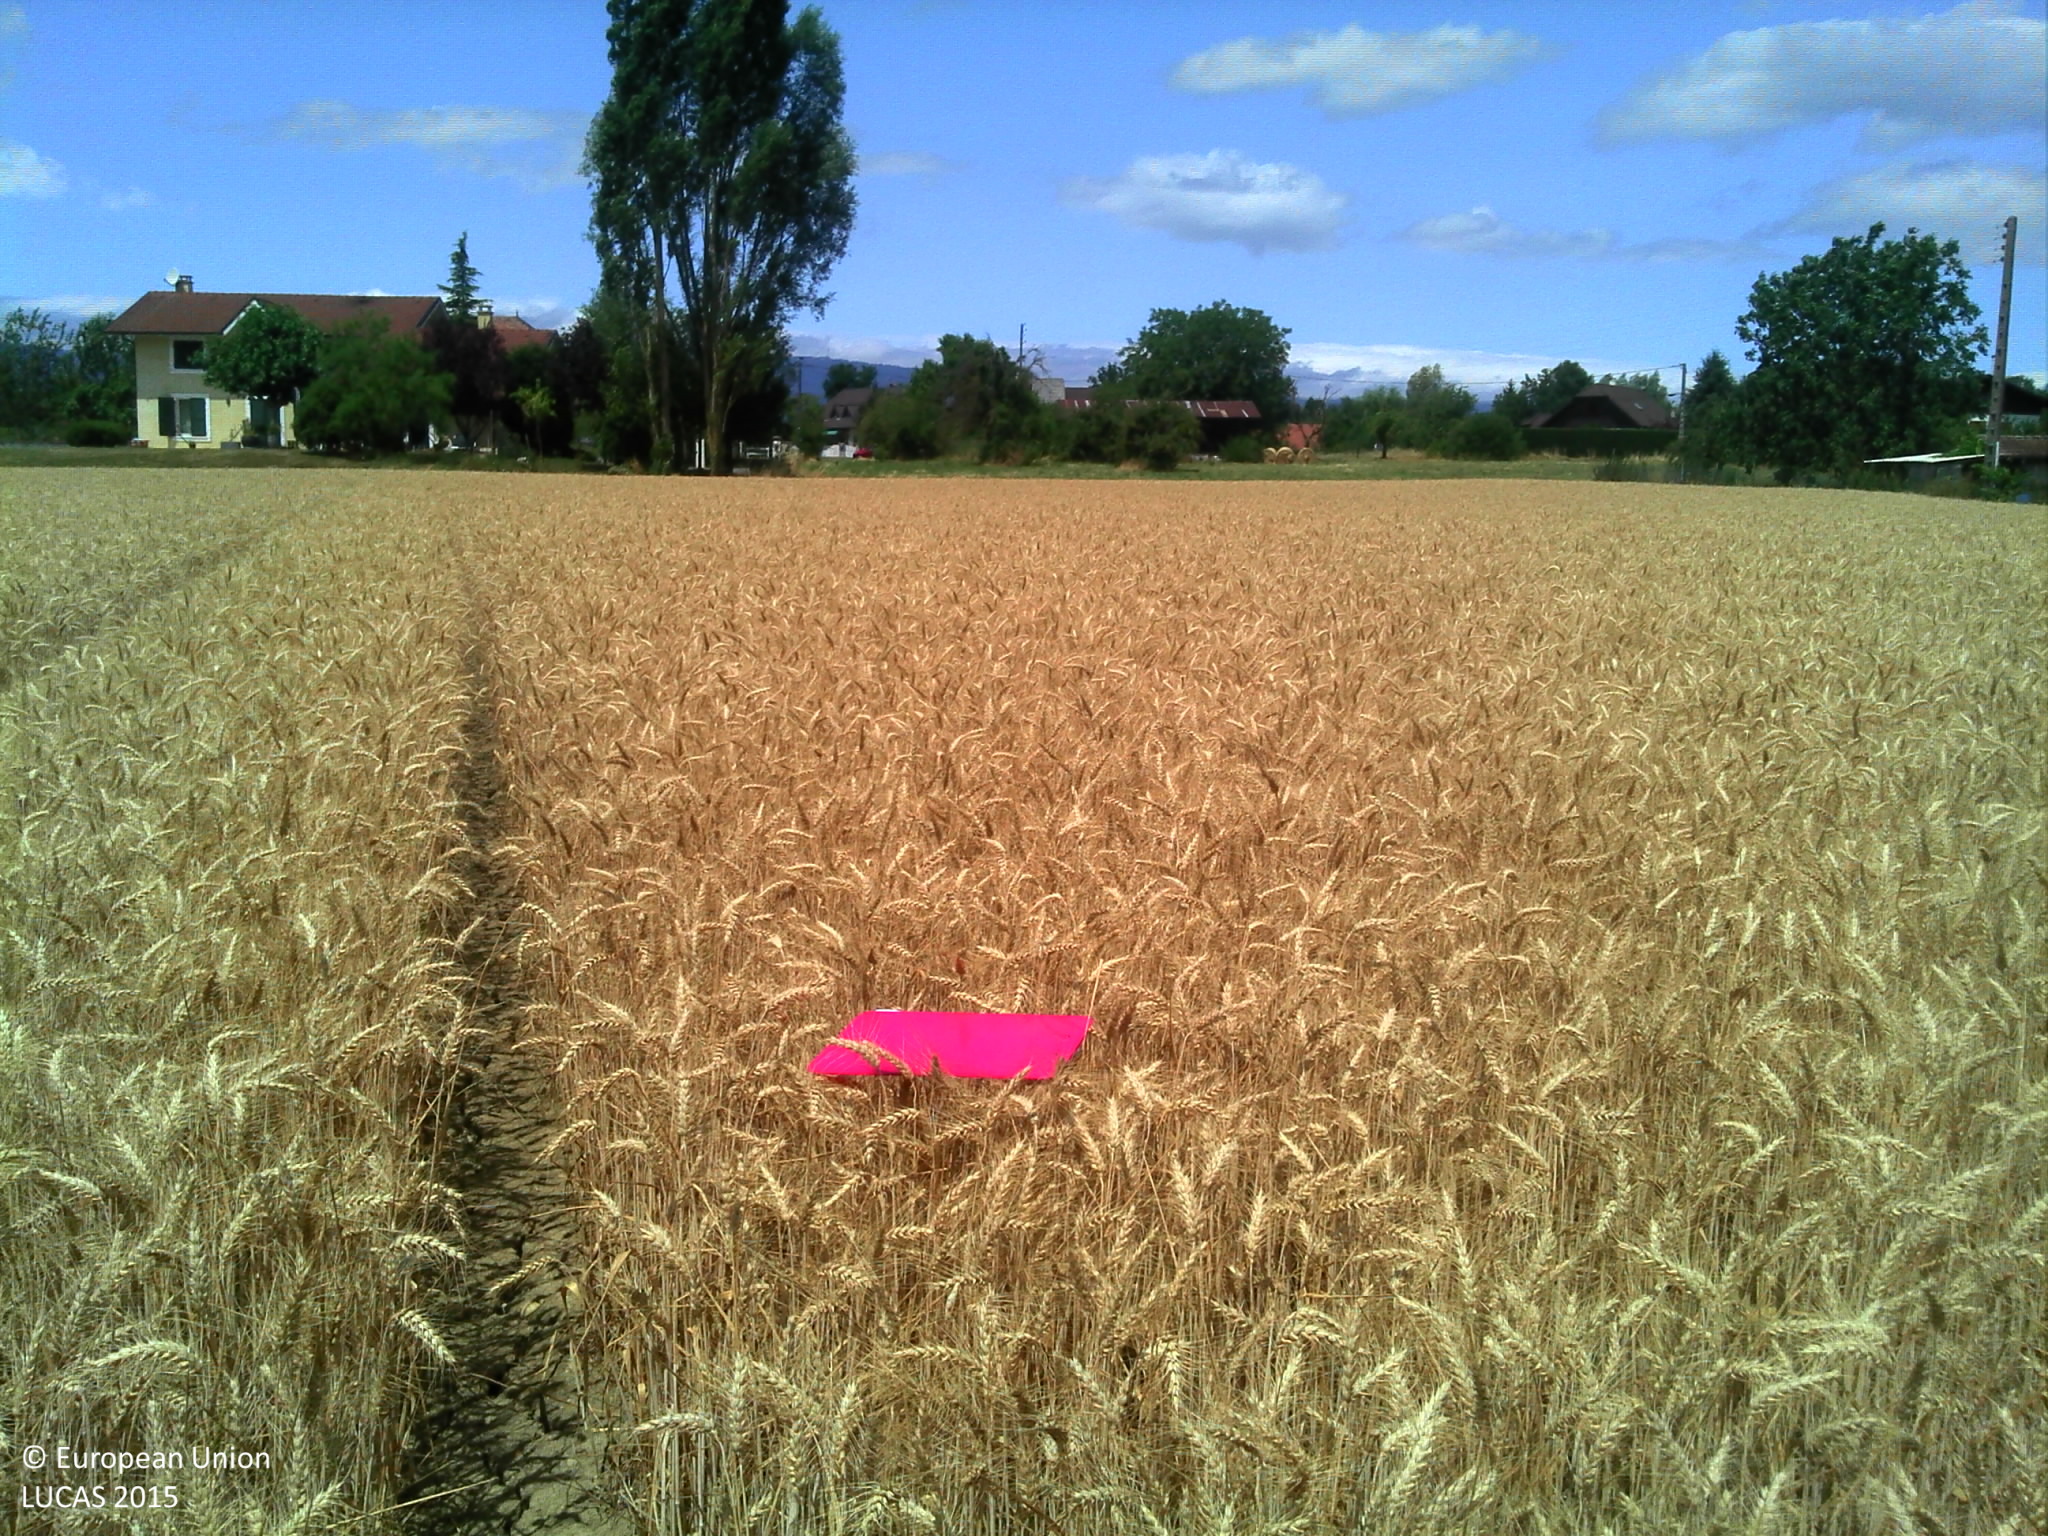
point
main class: Cropland
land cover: Durum wheat
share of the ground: > 75 %
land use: Agriculture (excluding fallow land and kitchen gardens)
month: July
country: FR
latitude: 46.3225
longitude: 6.2757
